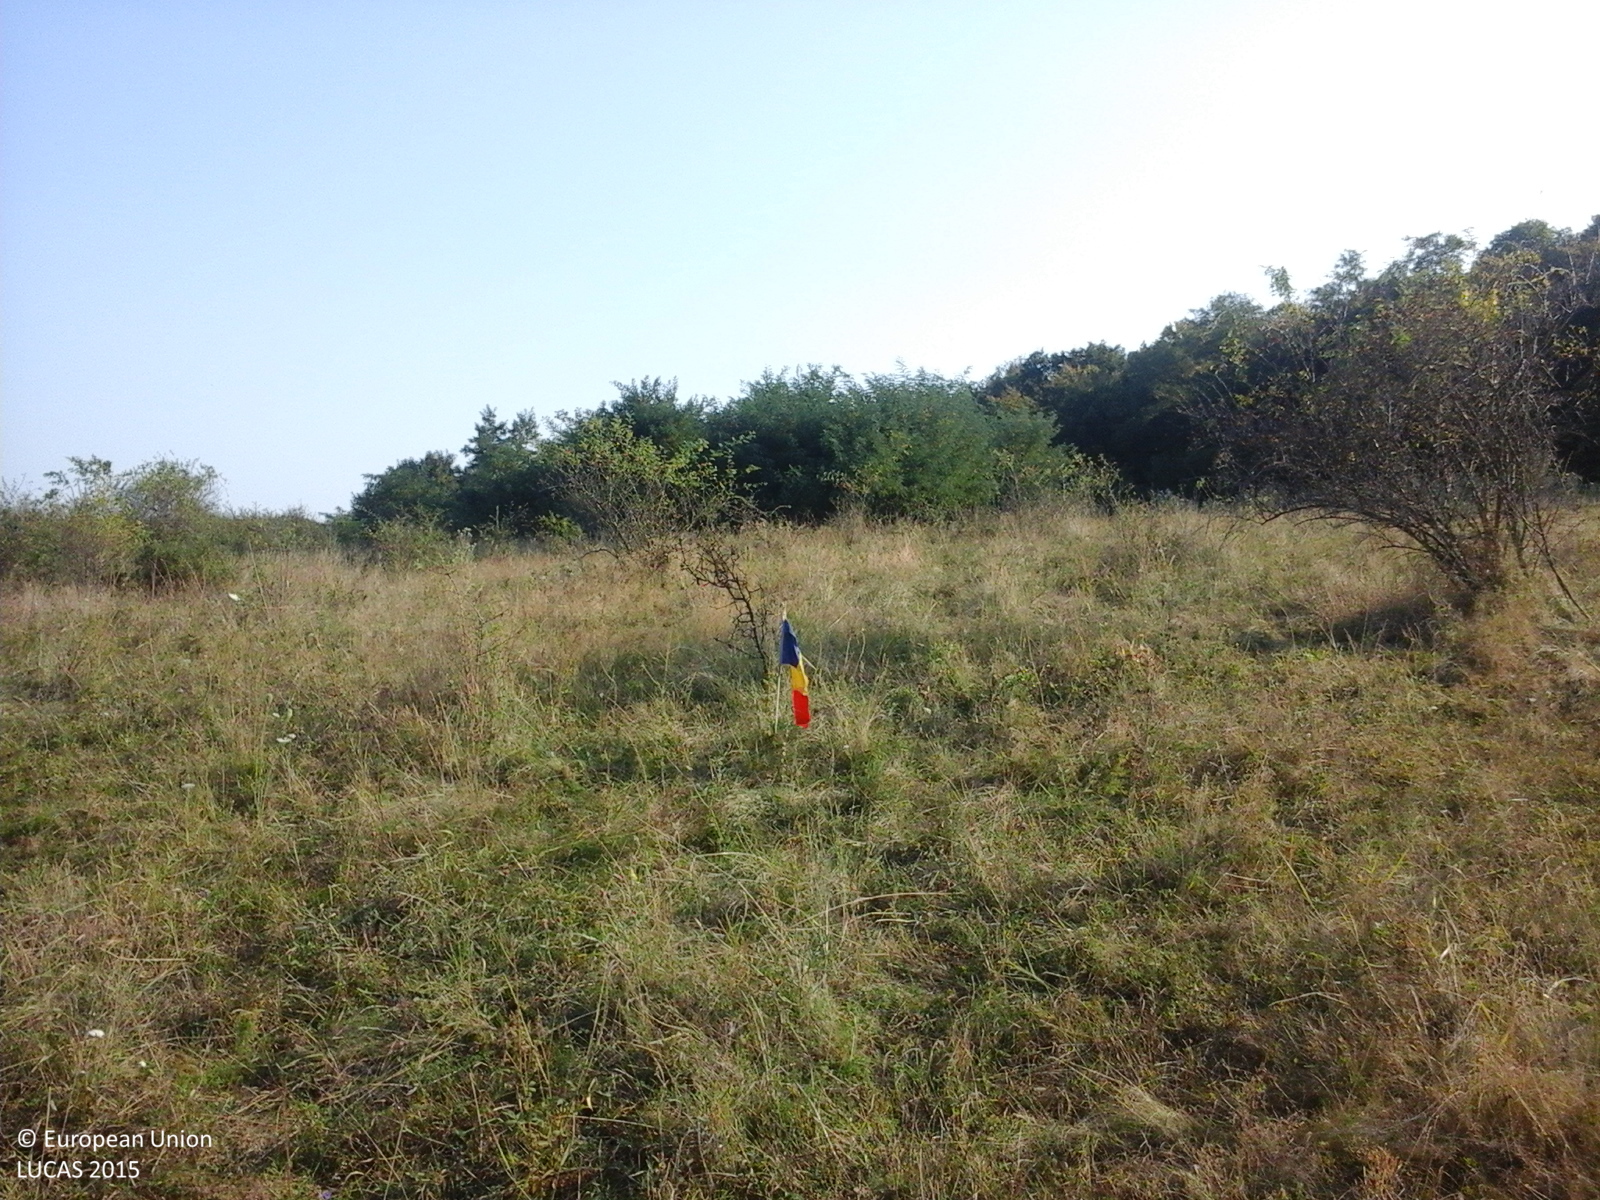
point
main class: Grassland
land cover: Grassland with sparse tree/shrub cover
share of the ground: > 75 %
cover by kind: herbaceous plants 85 %, shrubs 10 %, broadleaved forest trees 5 %
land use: Agriculture (excluding fallow land and kitchen gardens)
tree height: < 5 m
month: September
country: RO
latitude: 47.0594
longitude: 24.2115
